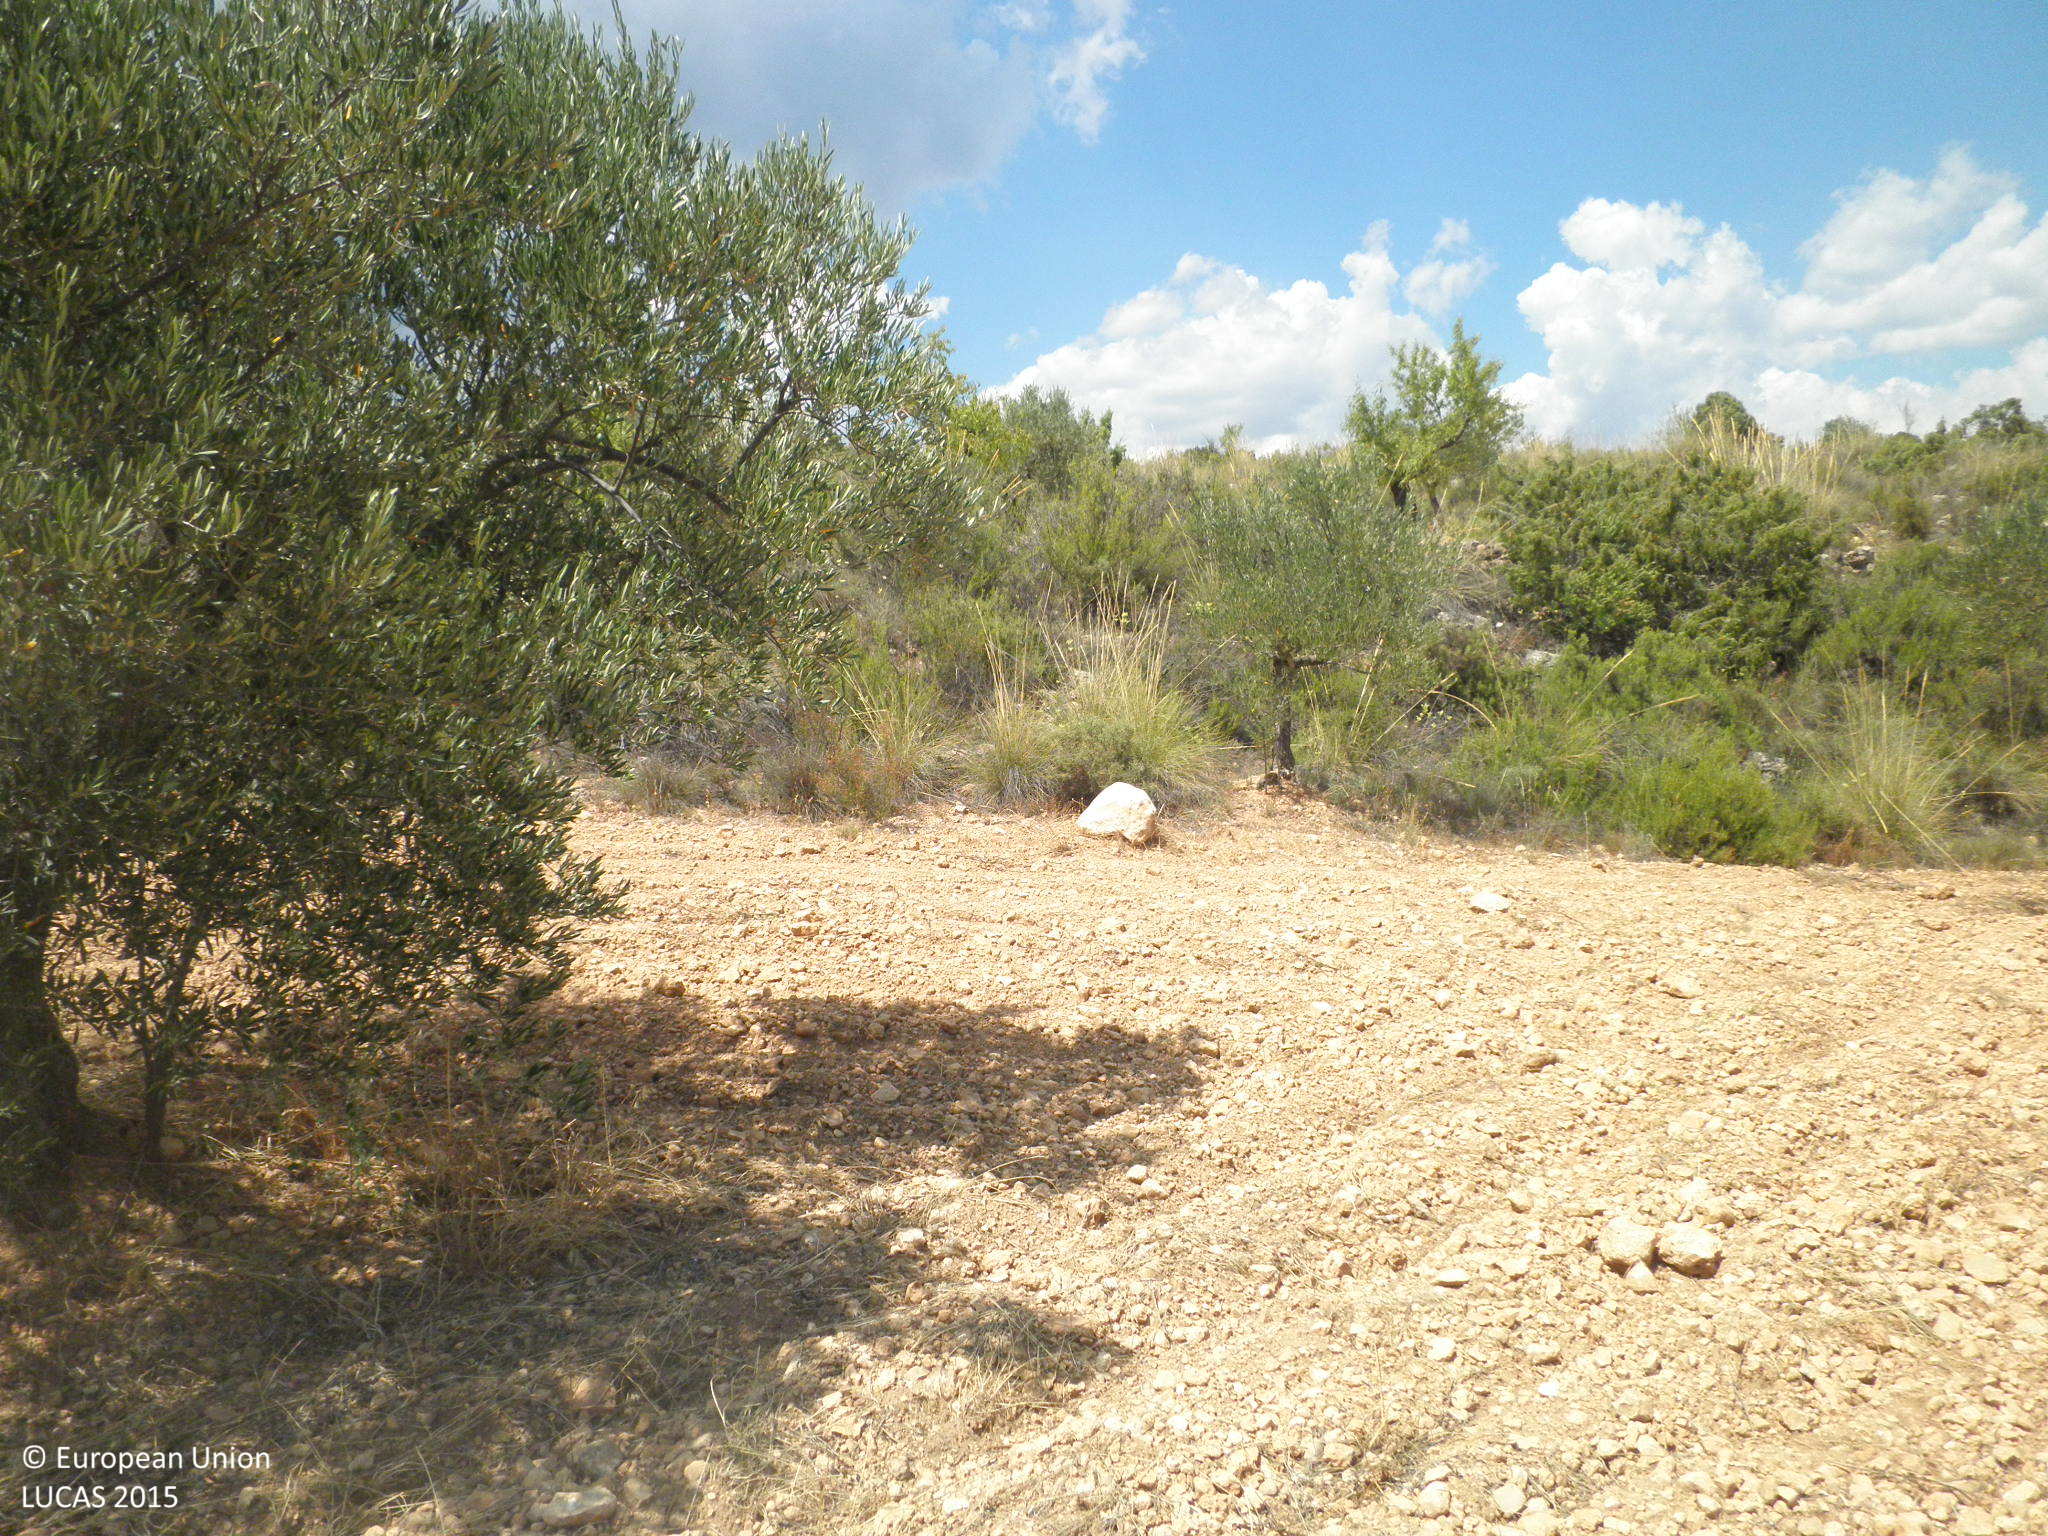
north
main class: Cropland
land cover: Olive groves
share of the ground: 10 - 25 %
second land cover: Other bare soil
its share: > 75 %
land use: Agriculture (excluding fallow land and kitchen gardens)
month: July
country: ES
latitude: 39.6675
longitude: -1.6054
